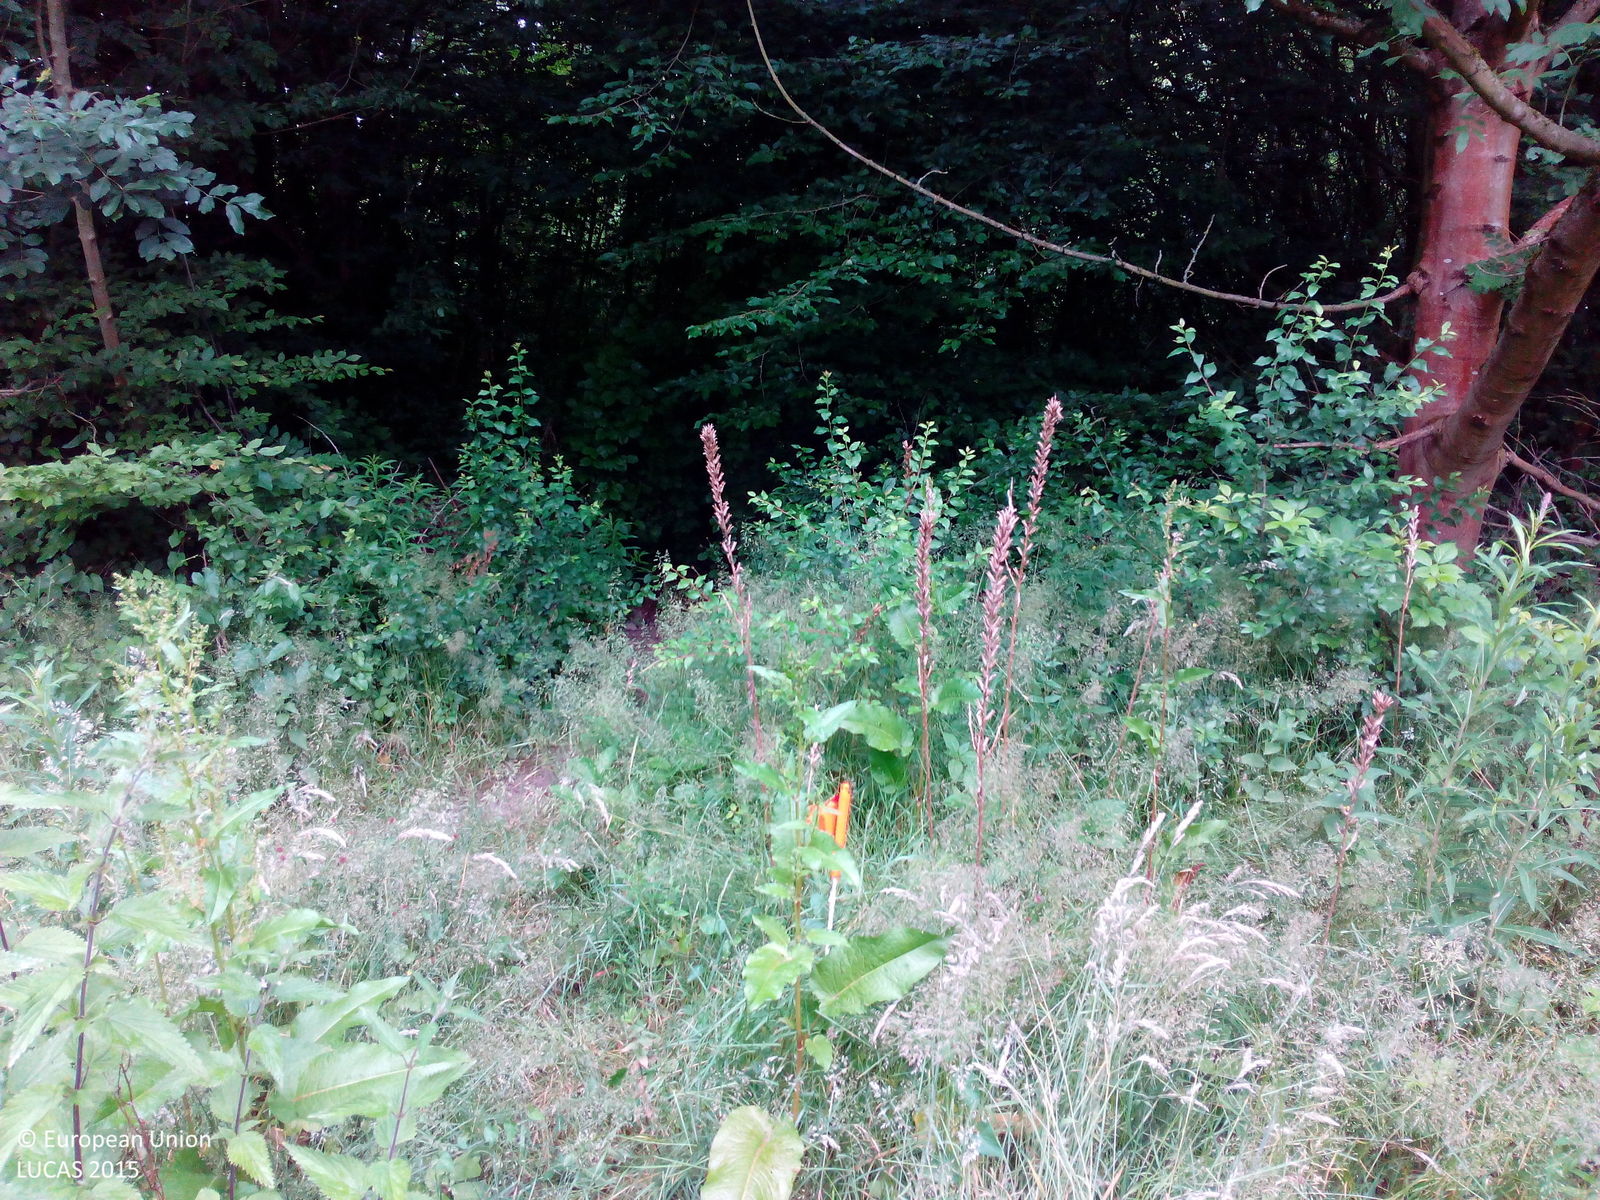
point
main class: Woodland
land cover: Broadleaved woodland
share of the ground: 50 - 75 %
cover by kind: broadleaved forest trees 70 %, herbaceous plants 30 %
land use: Residential
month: June
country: DE
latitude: 51.6579
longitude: 9.6387
